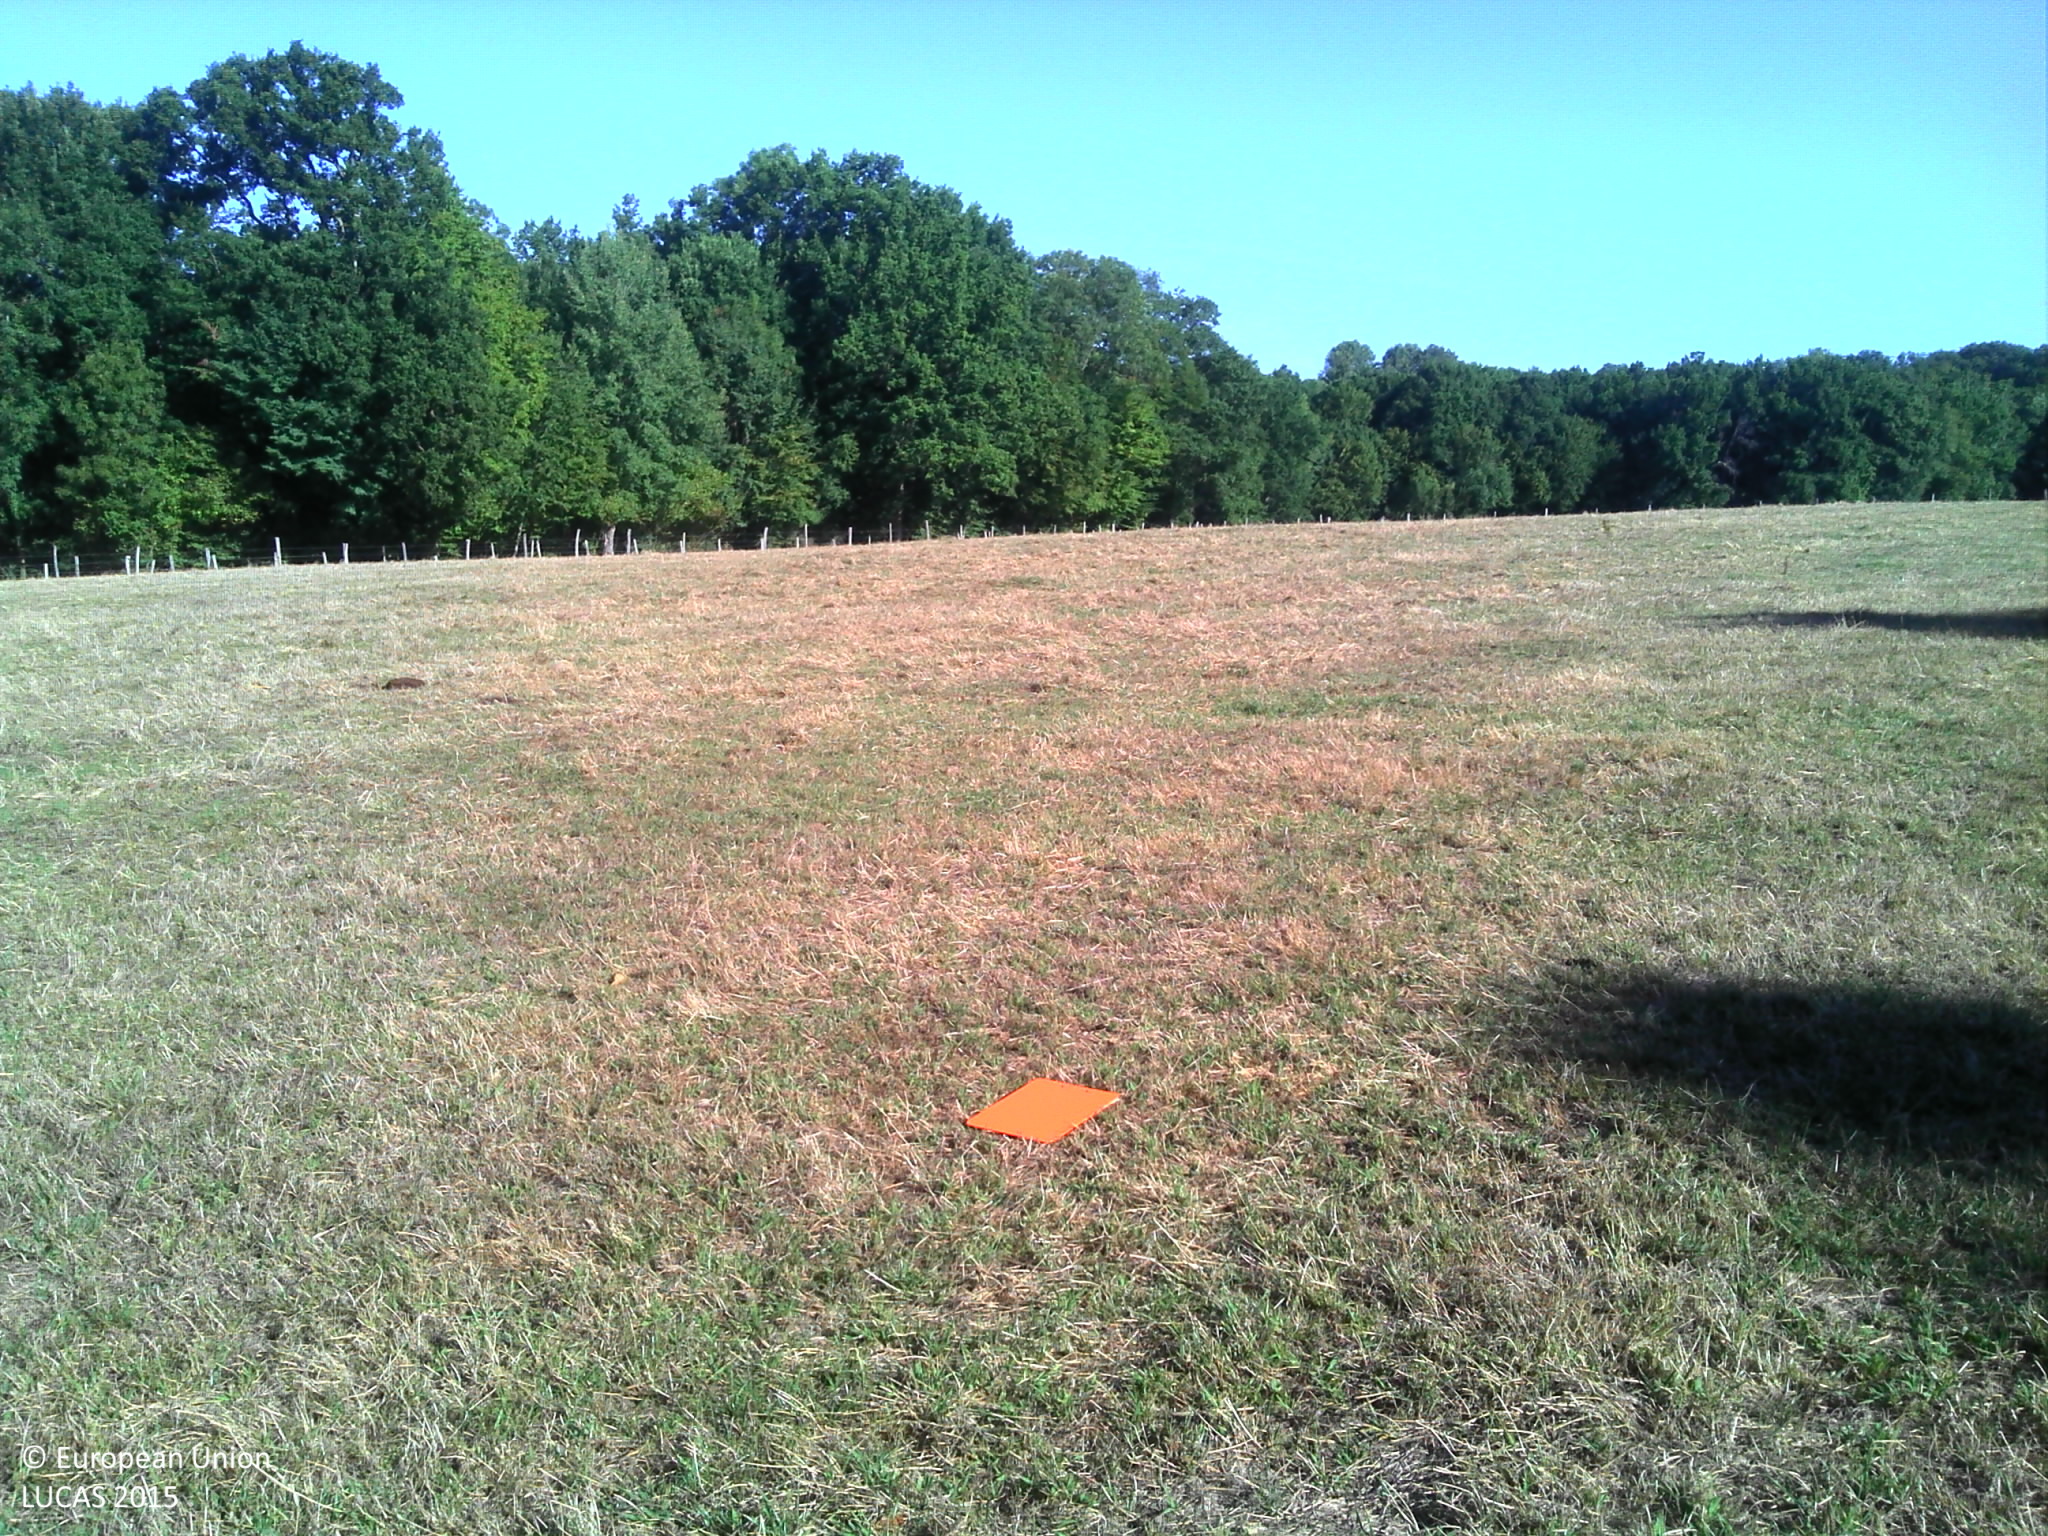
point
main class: Grassland
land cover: Grassland without tree/shrub cover
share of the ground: > 75 %
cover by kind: herbaceous plants 85 %, lichens and mosses 10 %, unconsolidated bare surface 5 %
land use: Agriculture (excluding fallow land and kitchen gardens)
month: August
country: FR
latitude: 48.8030
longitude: 3.4171
